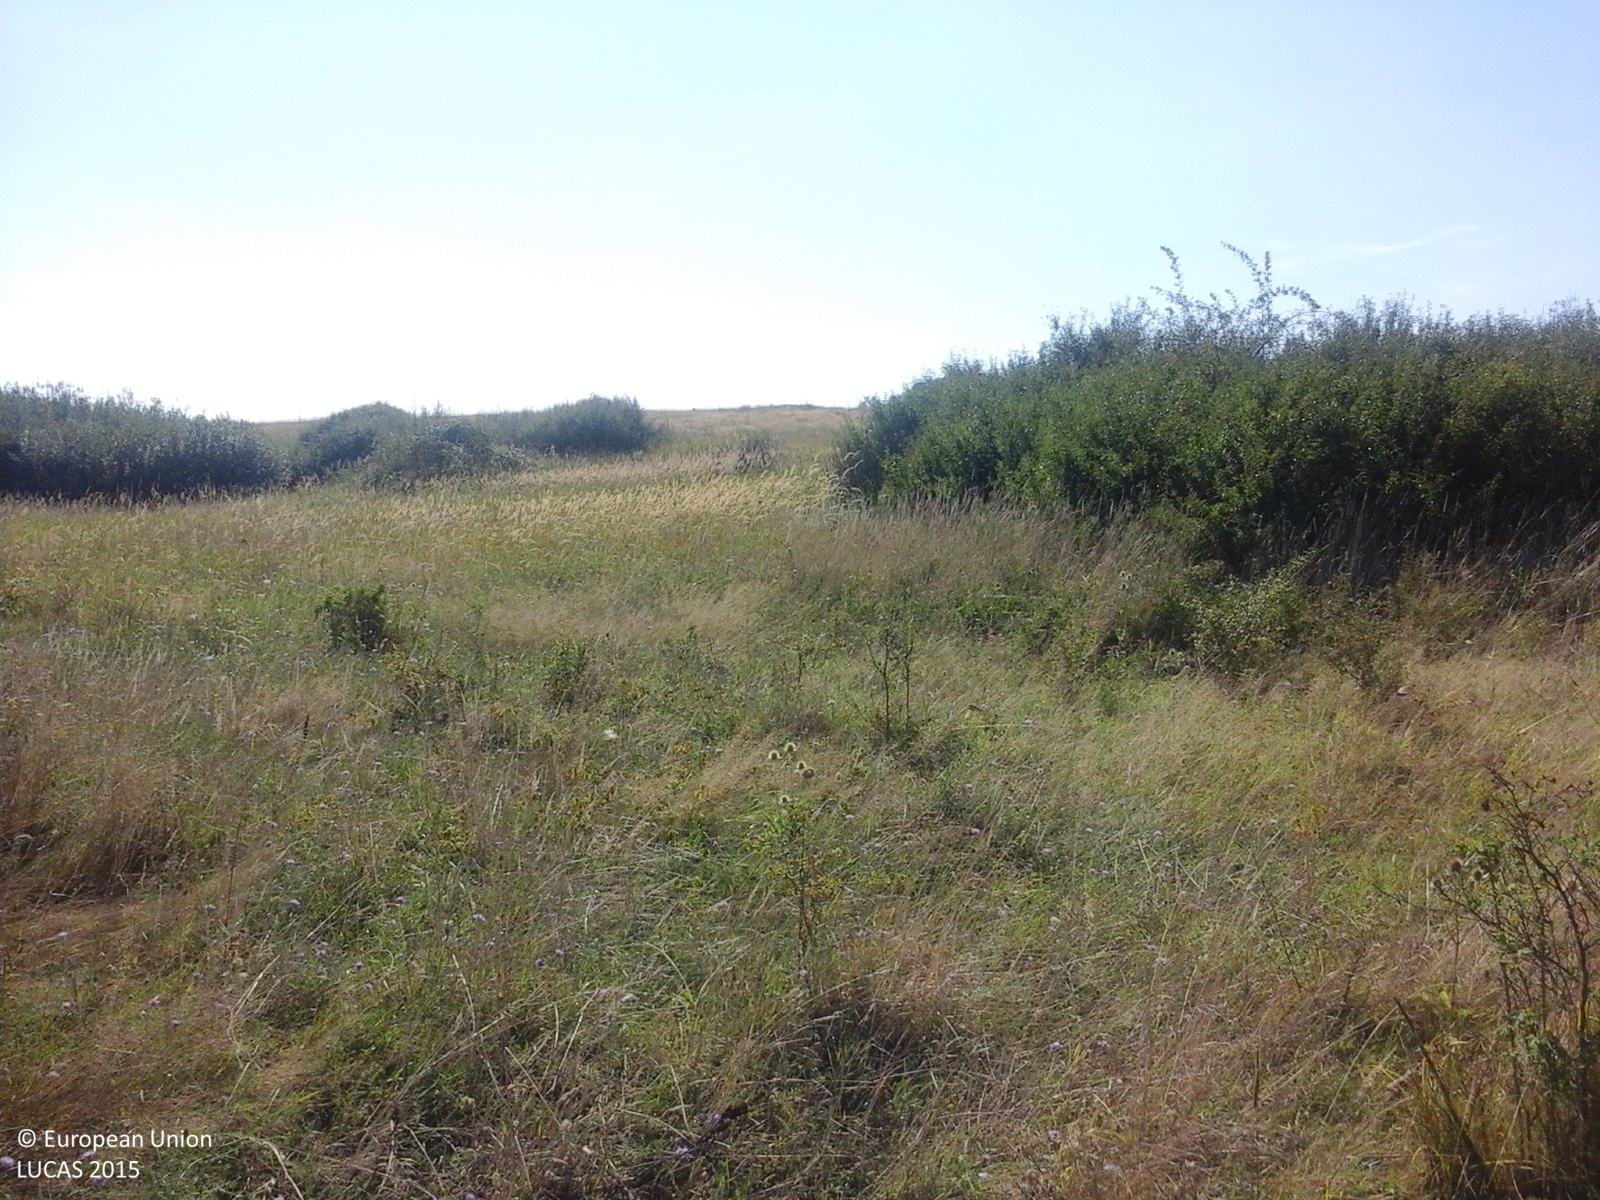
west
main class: Grassland
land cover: Grassland with sparse tree/shrub cover
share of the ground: > 75 %
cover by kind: herbaceous plants 90 %, broadleaved forest trees 5 %, shrubs 5 %
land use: Agriculture (excluding fallow land and kitchen gardens)
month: August
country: RO
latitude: 45.3678
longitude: 21.6391
